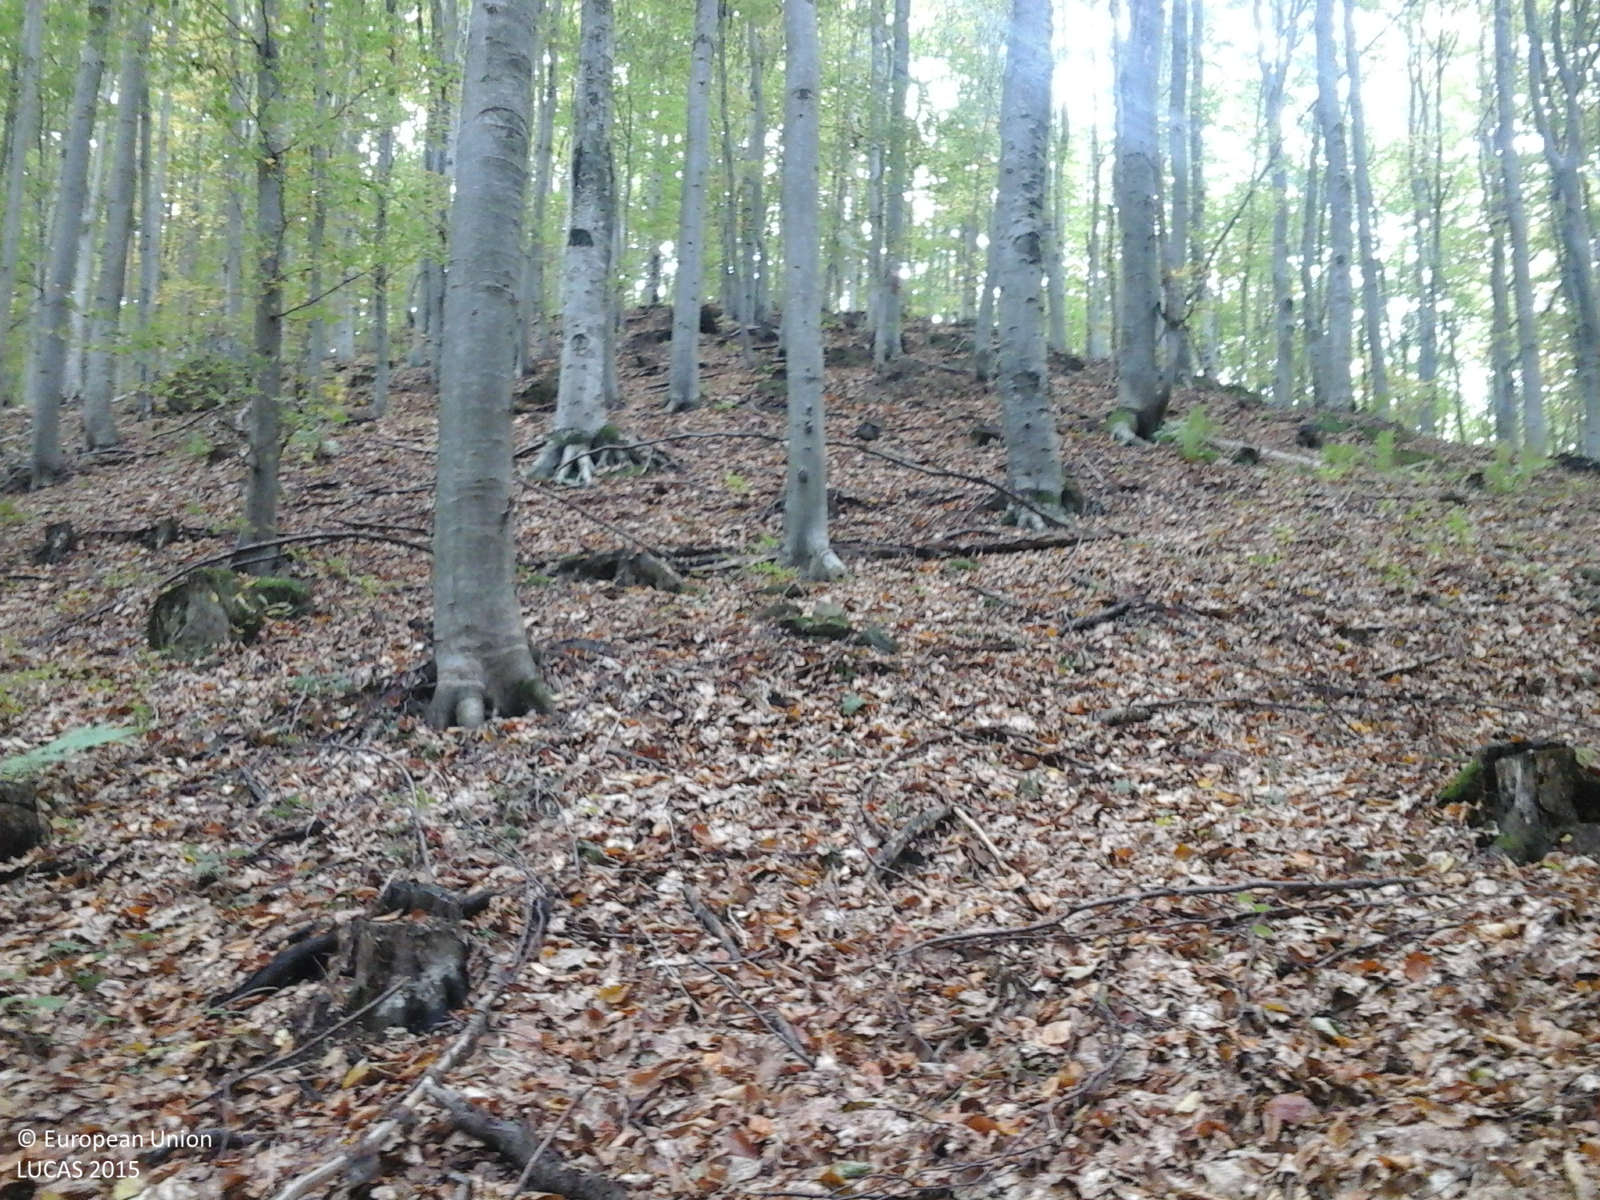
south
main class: Woodland
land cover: Broadleaved woodland
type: beech forest
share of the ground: > 75 %
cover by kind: broadleaved forest trees 100 %
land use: Forestry
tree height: > 5 m
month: October
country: RO
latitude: 46.6436
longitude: 24.9786
